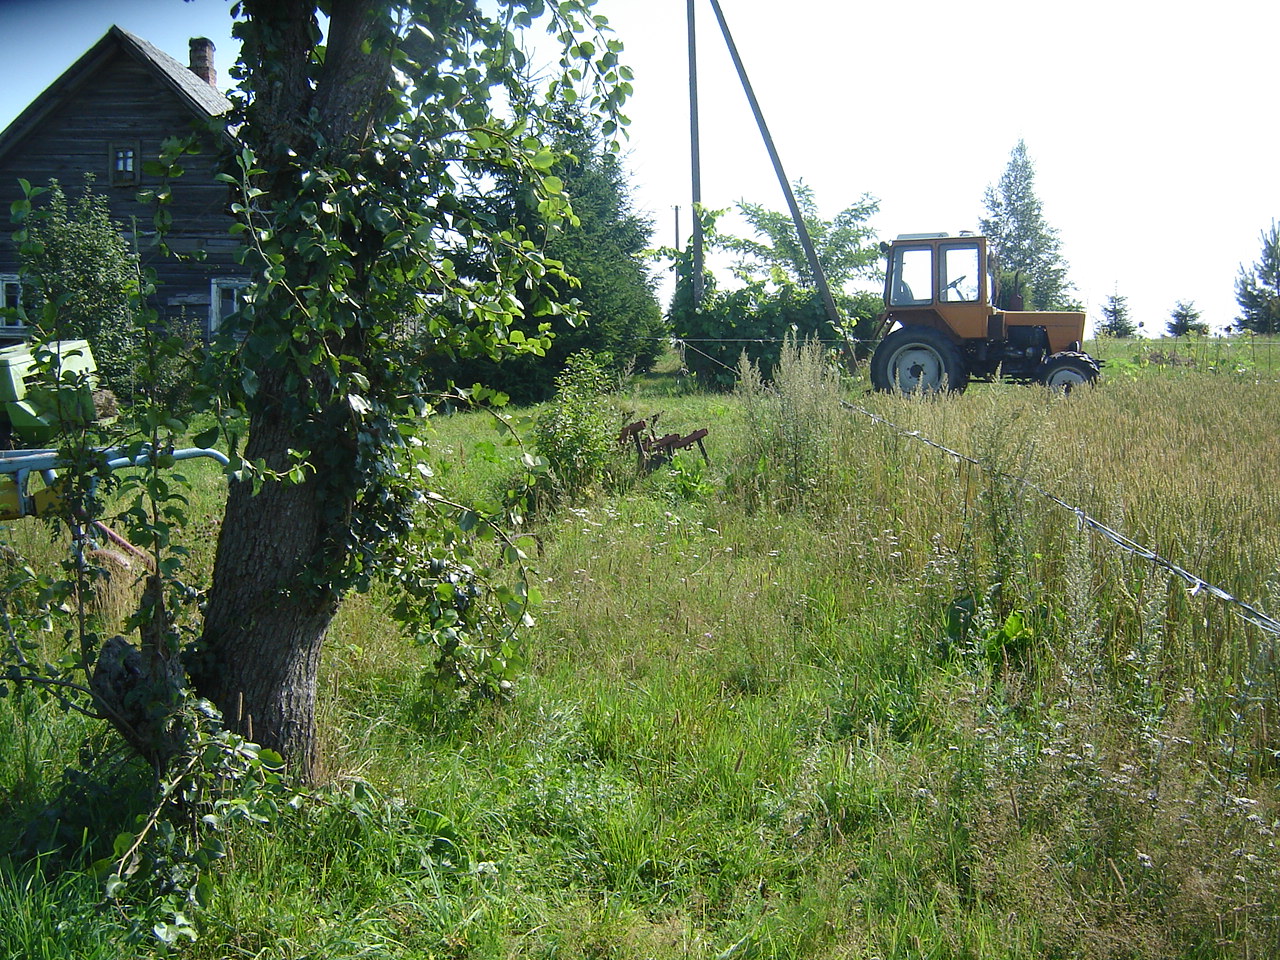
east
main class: Grassland
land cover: Grassland with sparse tree/shrub cover
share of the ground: > 75 %
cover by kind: herbaceous plants 95 %, broadleaved forest trees 5 %
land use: Residential
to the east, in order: Grassland with sparse tree/shrub cover; Artificial constructions in urban areas; Grassland with sparse tree/shrub cover; Spontaneously vegetated surfaces; Electric lines; Grassland with sparse tree/shrub cover; Spontaneously vegetated surfaces; Grassland with sparse tree/shrub cover
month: August
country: LT
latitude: 55.0740
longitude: 25.0400
